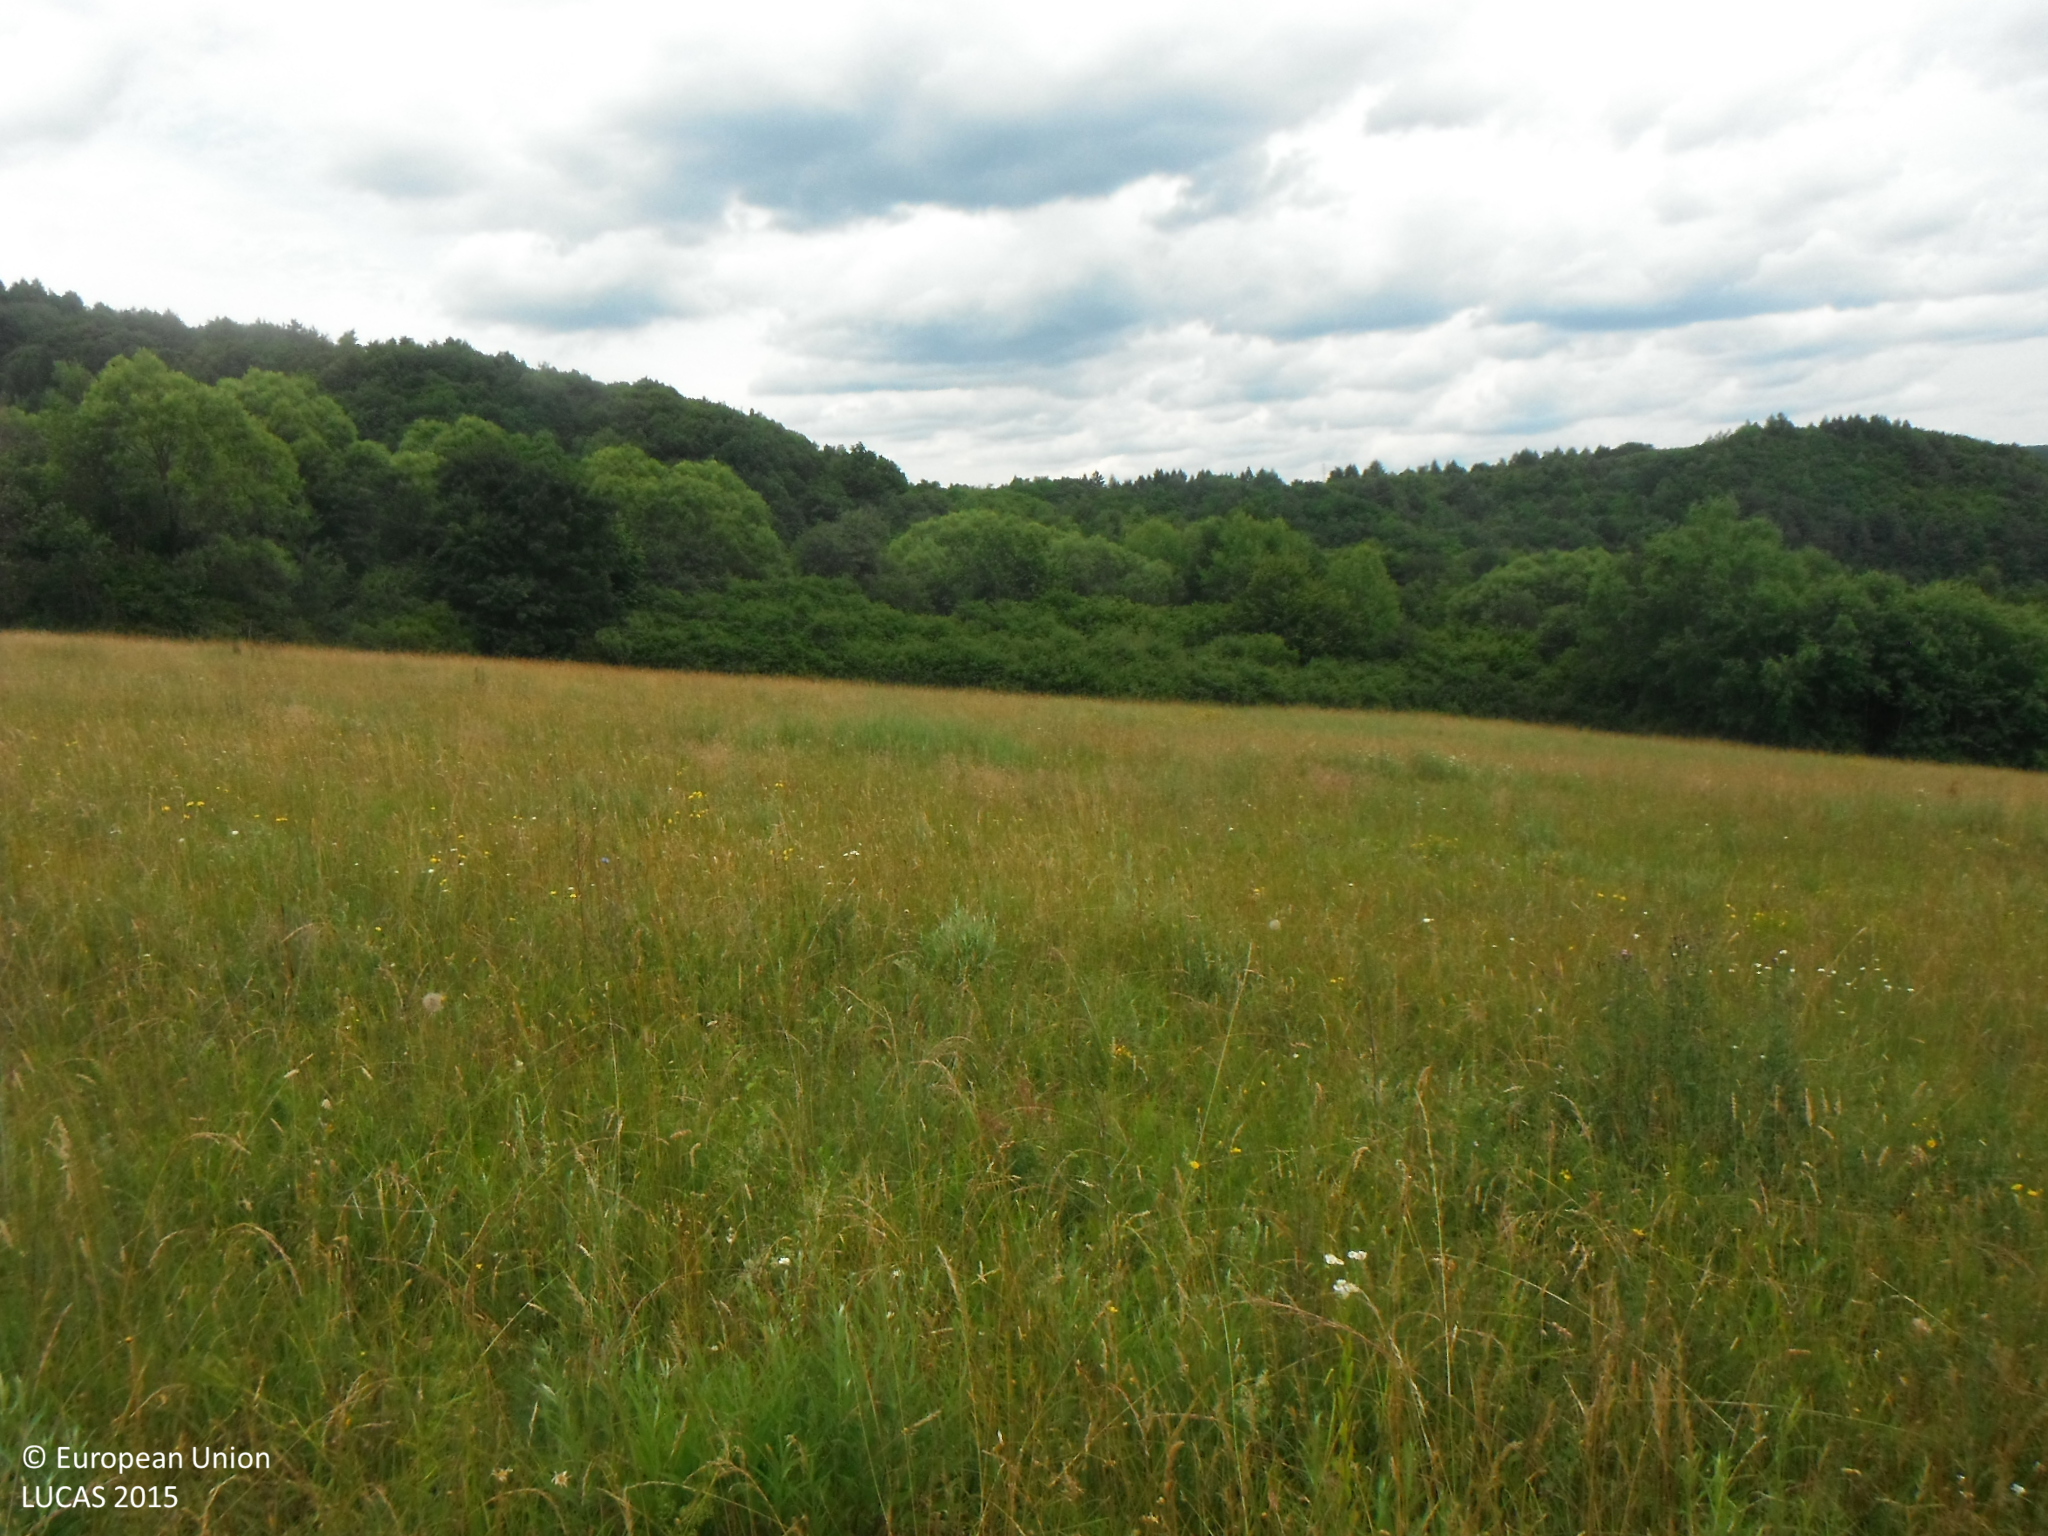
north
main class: Grassland
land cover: Grassland without tree/shrub cover
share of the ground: > 75 %
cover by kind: herbaceous plants 100 %
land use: Agriculture (excluding fallow land and kitchen gardens)
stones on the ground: < 10 %
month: June
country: SK
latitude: 49.0269
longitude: 21.9393
